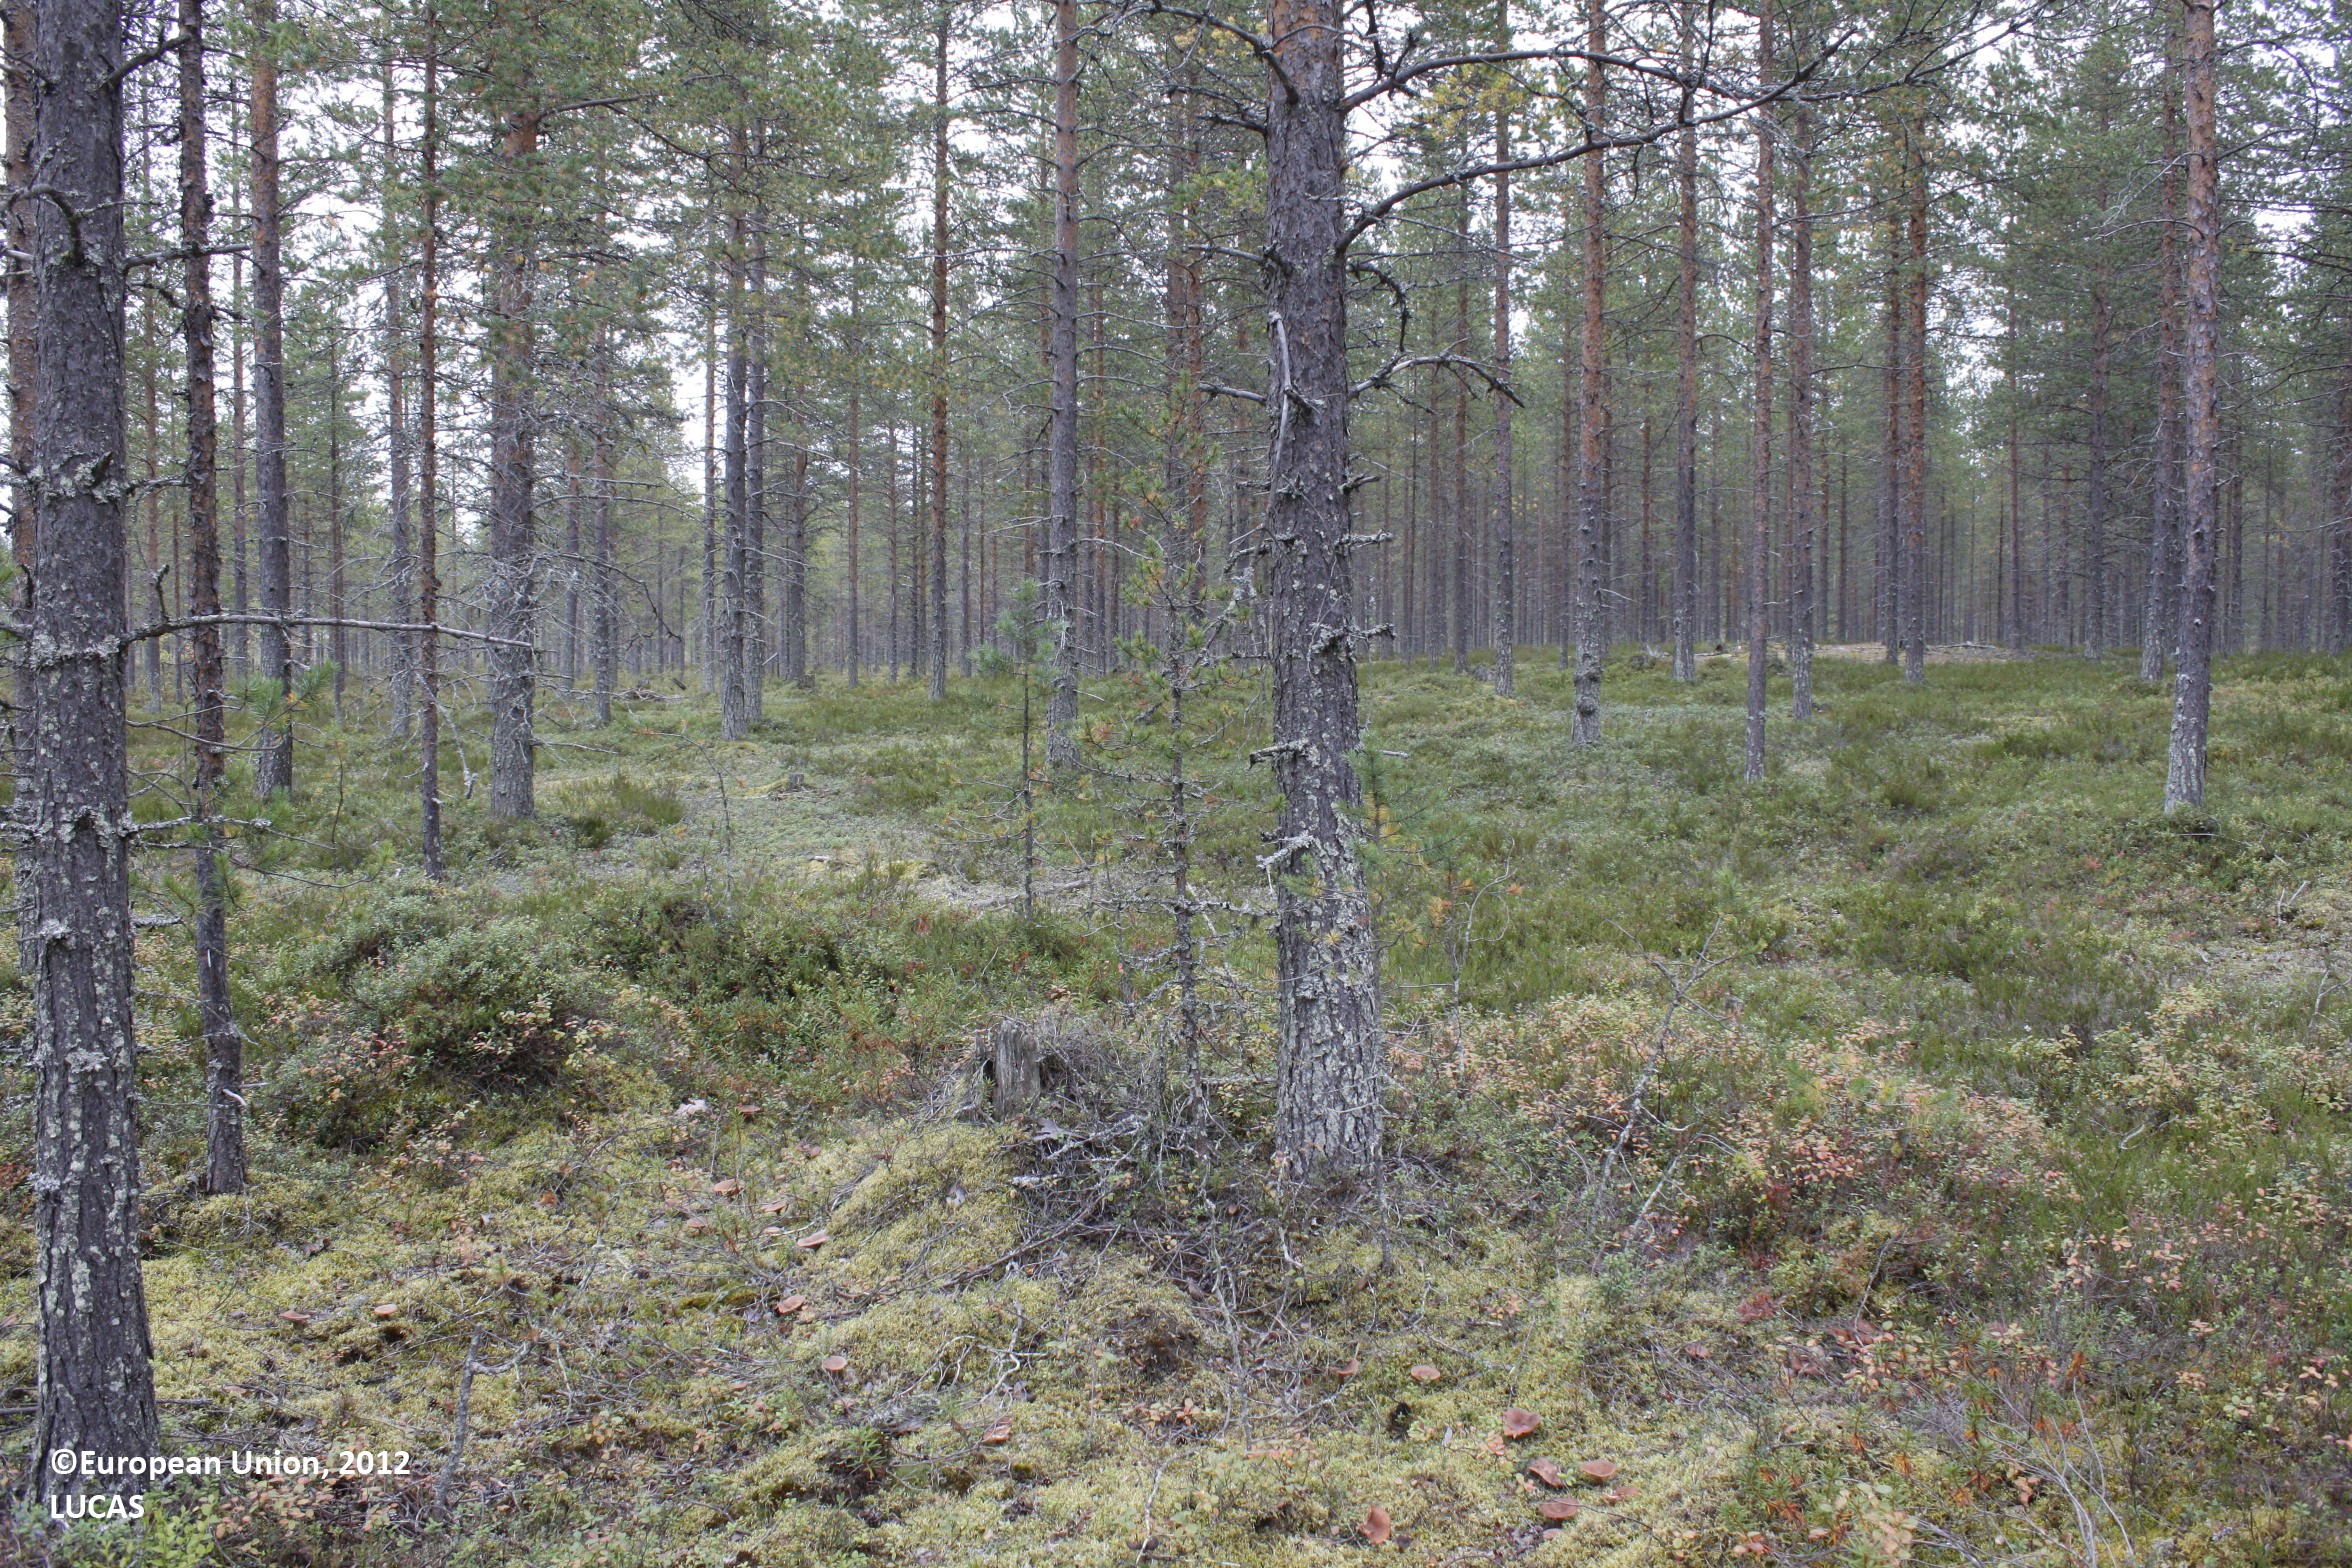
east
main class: Woodland
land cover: Pine dominated coniferous woodland
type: mire and swamp forests
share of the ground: 25 - 50 %
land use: Forestry
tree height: > 5 m
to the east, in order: Pine dominated coniferous woodland; Peatbogs
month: September
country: FI
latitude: 65.4316
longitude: 26.5499
